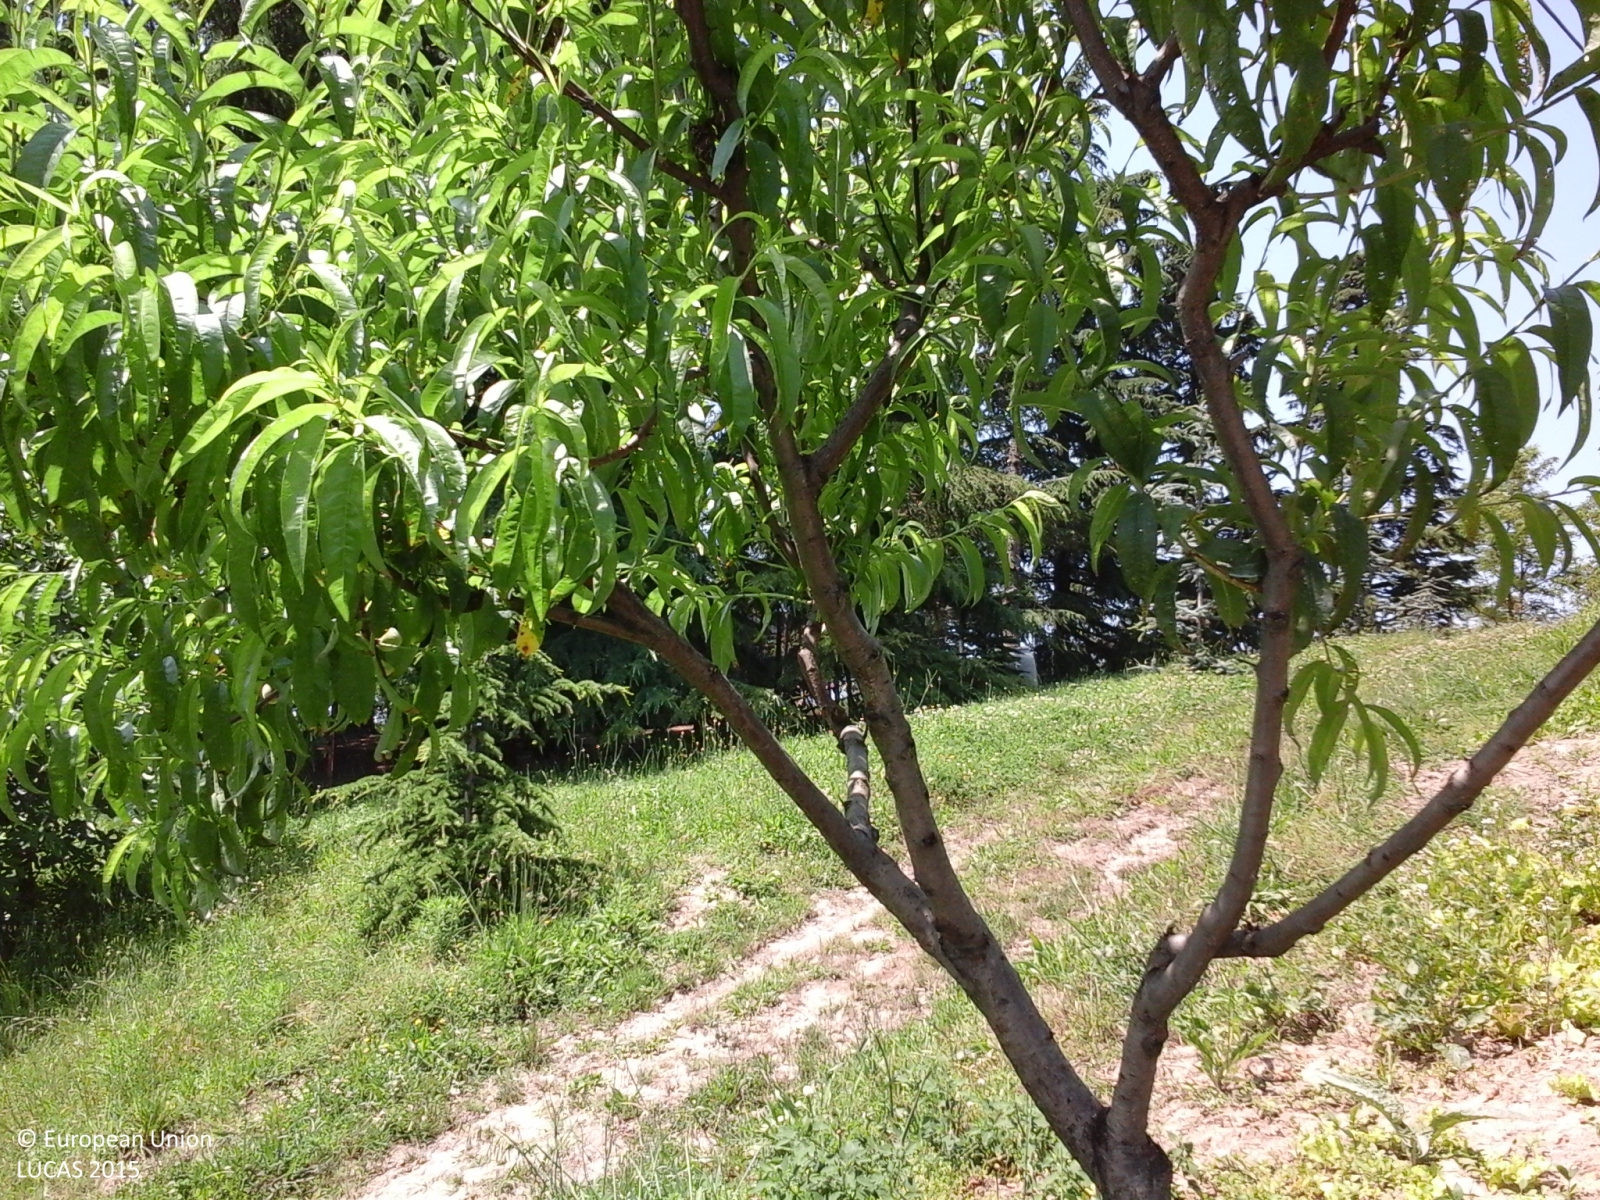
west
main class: Cropland
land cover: Apple fruit
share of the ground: 50 - 75 %
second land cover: Spontaneously vegetated surfaces
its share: 50 - 75 %
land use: Kitchen garden
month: June
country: IT
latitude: 44.4339
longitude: 11.1908
